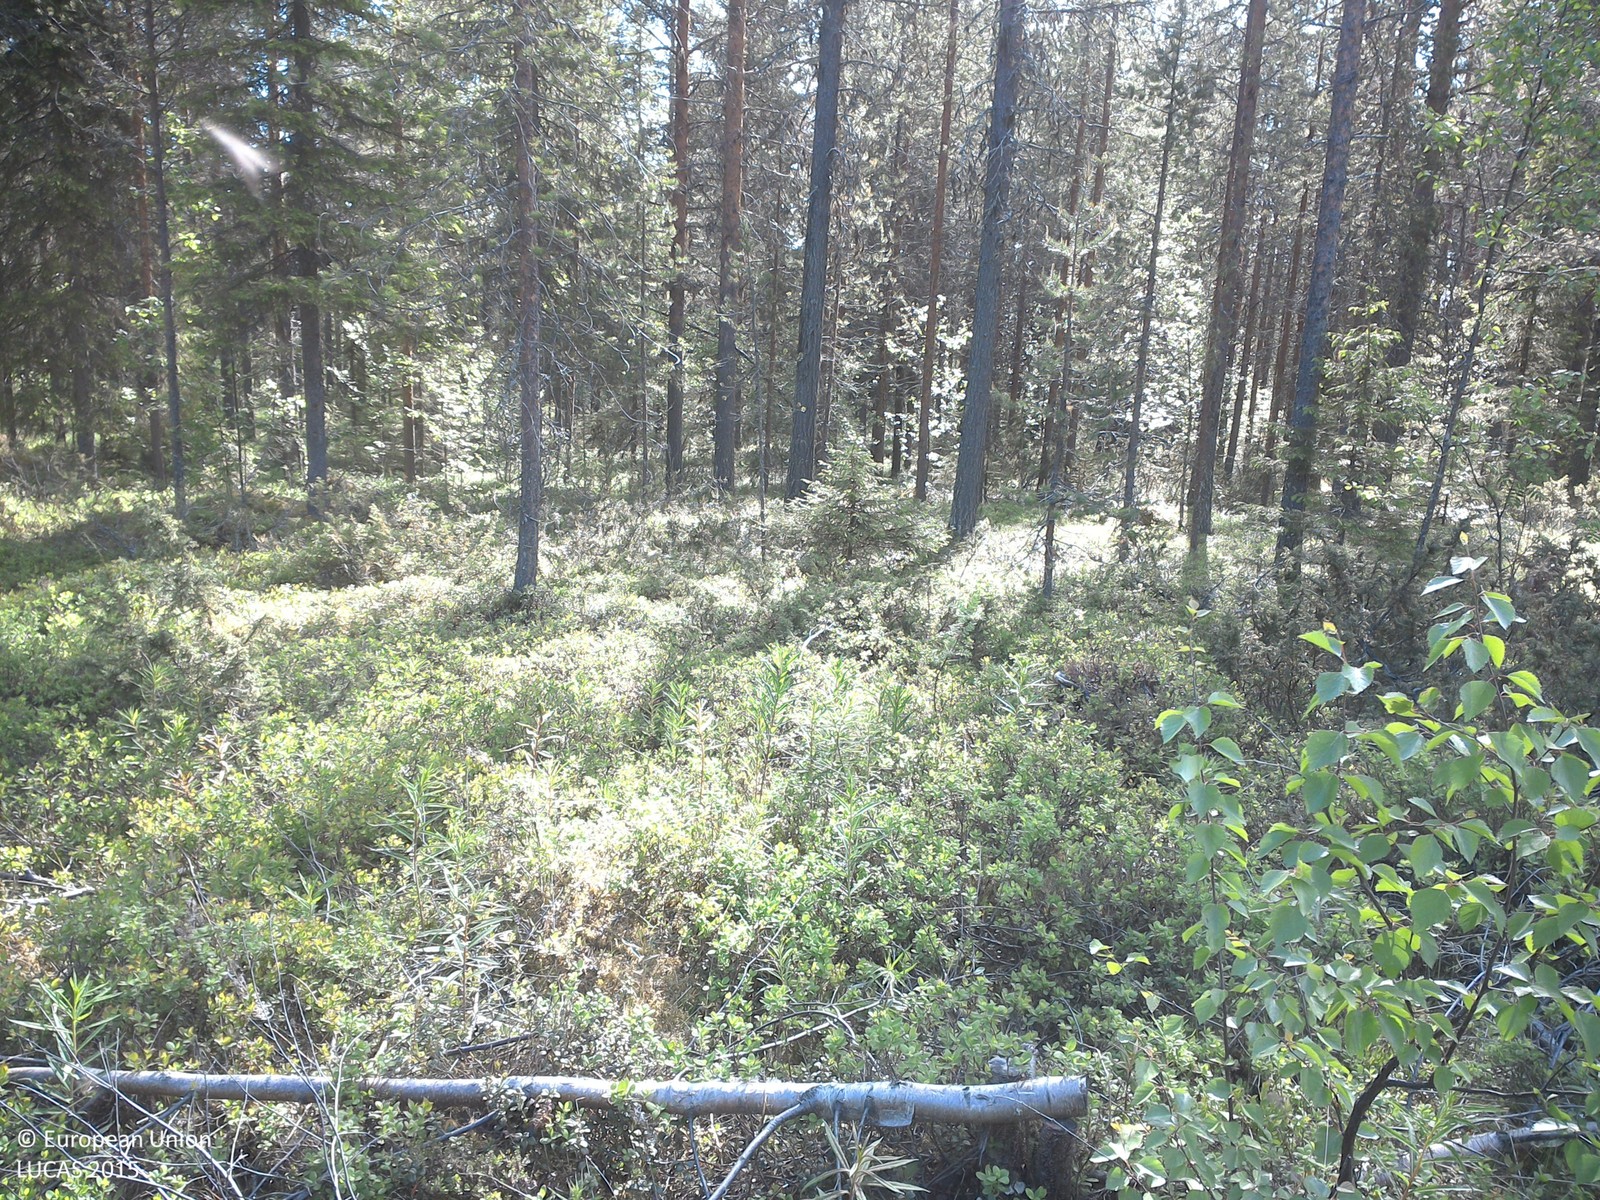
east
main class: Woodland
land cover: Broadleaved woodland
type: boreal forest
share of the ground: 10 - 25 %
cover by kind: shrubs 70 %, broadleaved forest trees 15 %, lichens and mosses 10 %, herbaceous plants 5 %
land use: Community services
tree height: < 5 m
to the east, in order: Broadleaved woodland; Pine dominated mixed woodland; Spruce dominated mixed woodland; Broadleaved woodland; Ditches and canals; Grassland with sparse tree/shrub cover; Ditches and canals; Grassland with sparse tree/shrub cover; Grassland without tree/shrub cover; Grassland with sparse tree/shrub cover
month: June
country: SE
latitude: 66.8544
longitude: 23.0364
